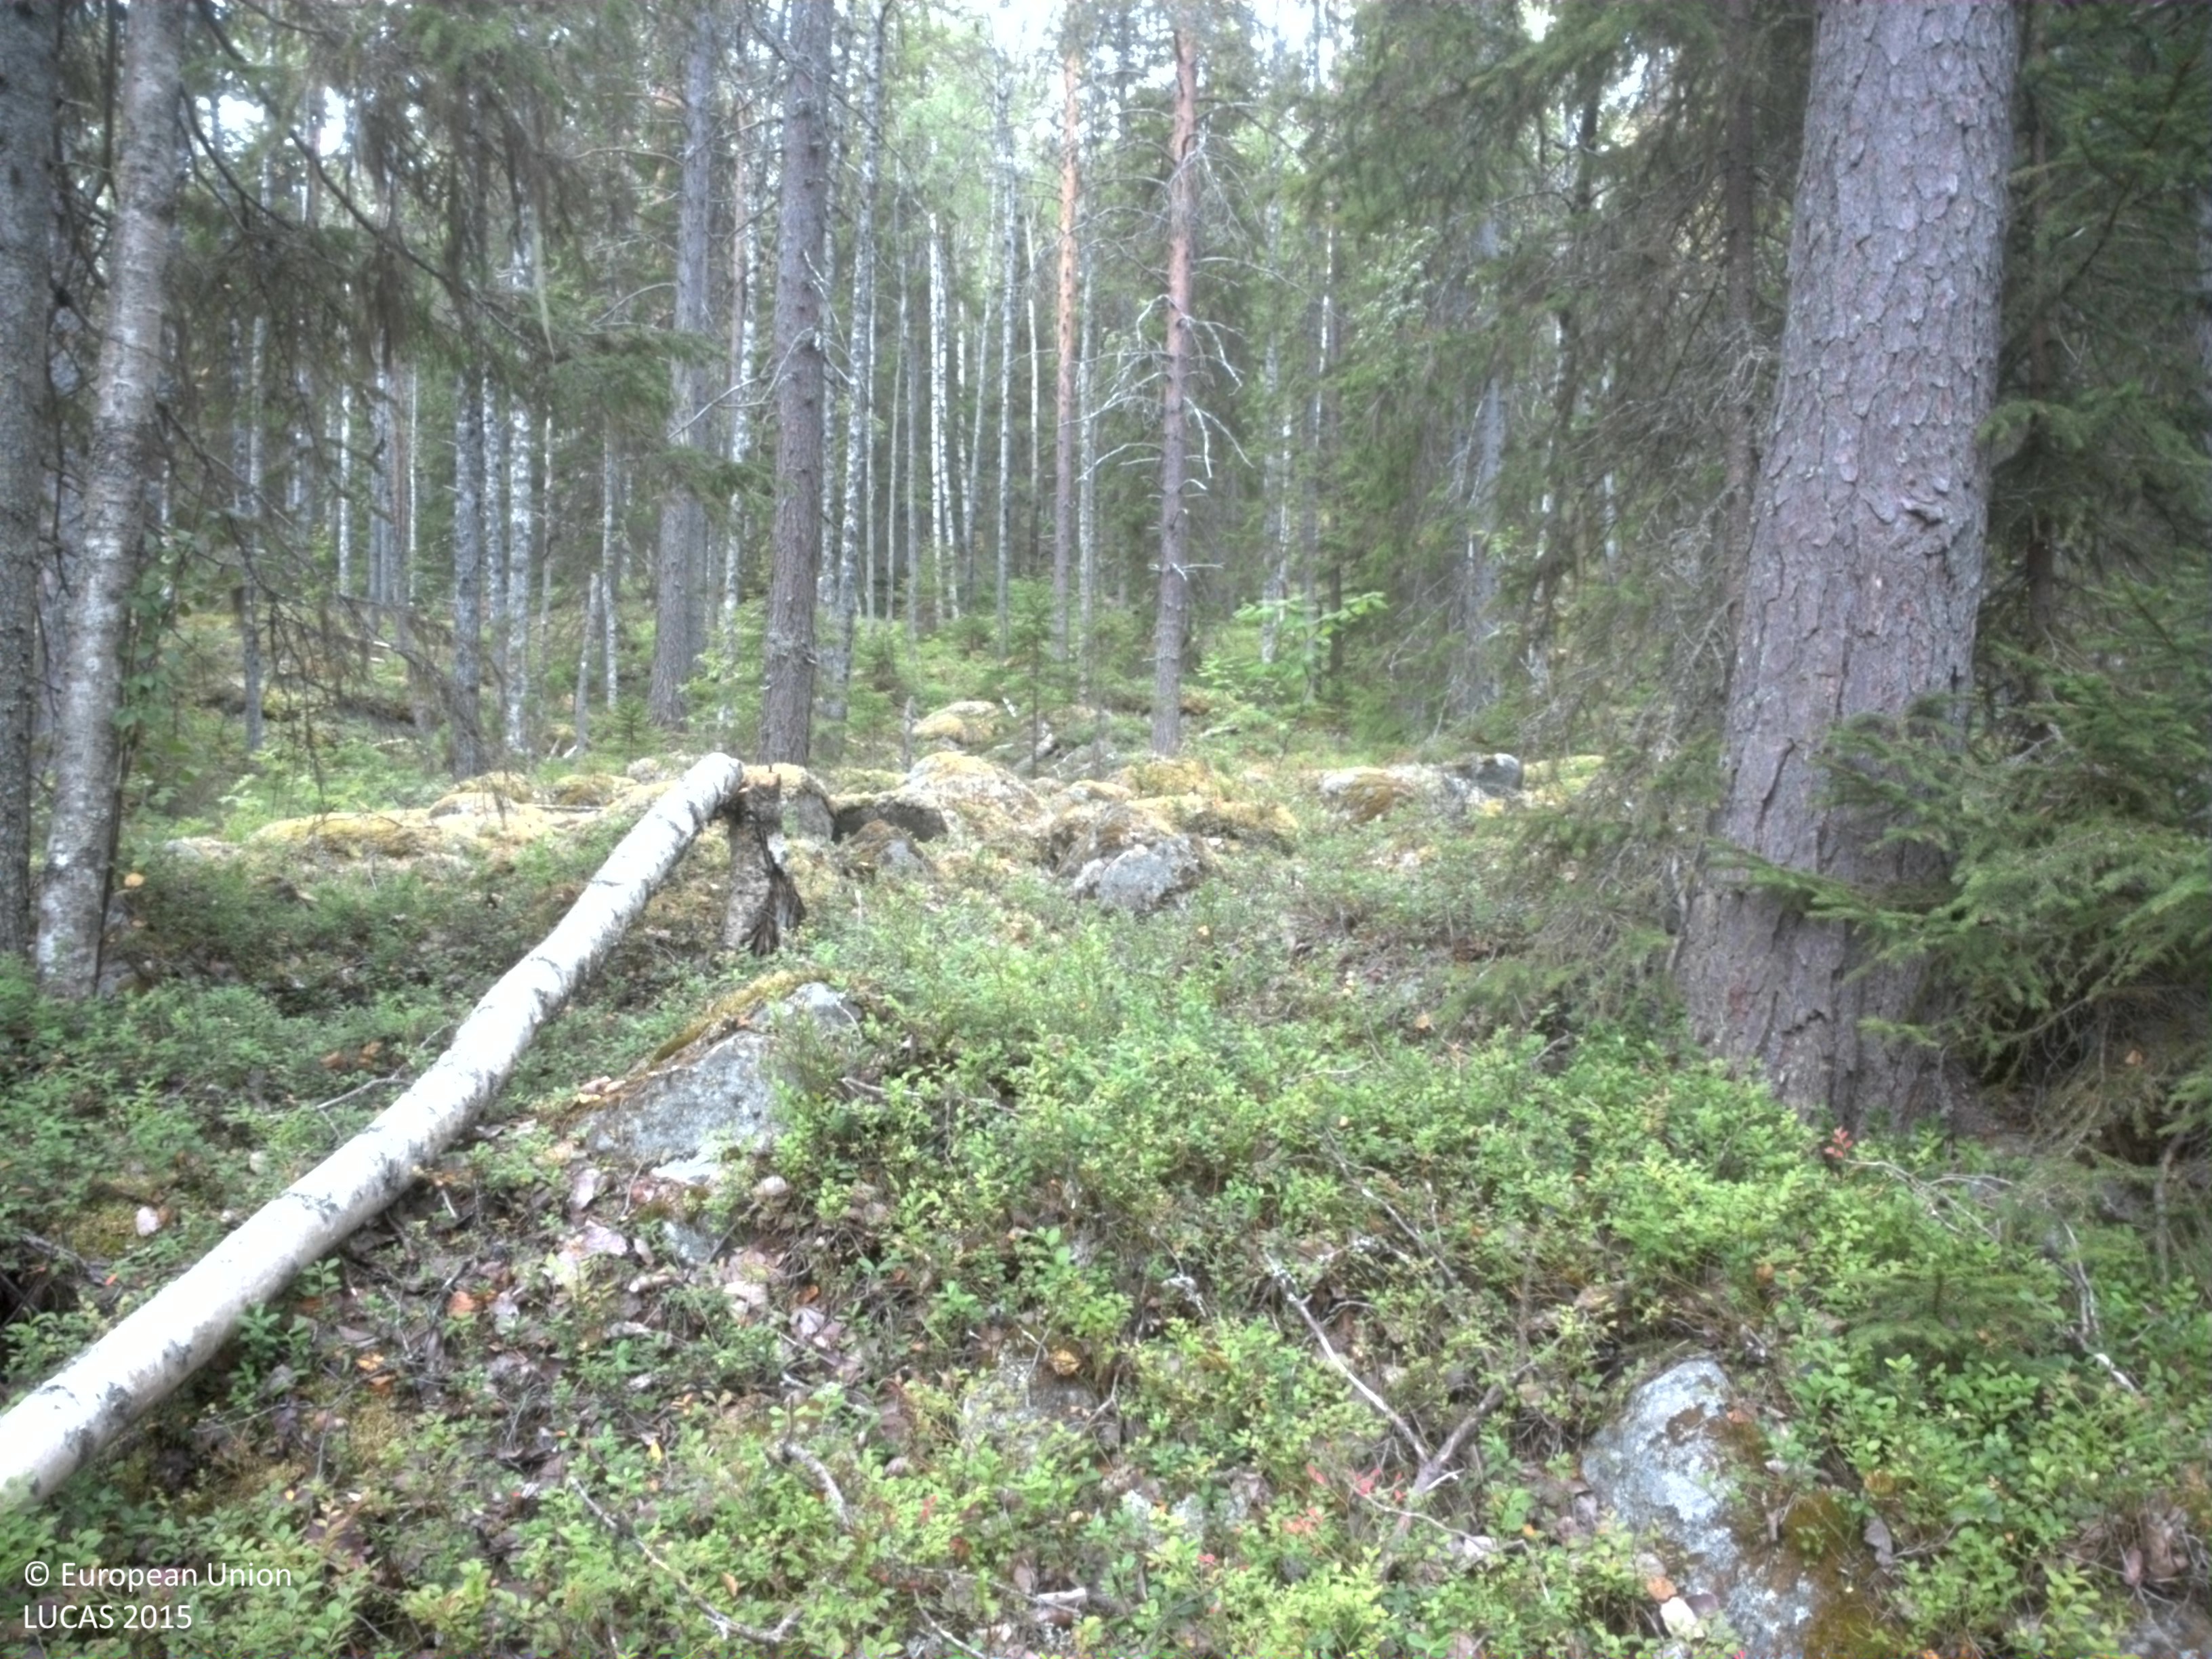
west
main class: Woodland
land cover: Spruce dominated mixed woodland
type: boreal forest
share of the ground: 50 - 75 %
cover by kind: coniferous forest trees 45 %, shrubs 30 %, broadleaved forest trees 15 %, lichens and mosses 10 %
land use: Forestry
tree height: > 5 m
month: September
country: SE
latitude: 64.6064
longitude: 19.7739
